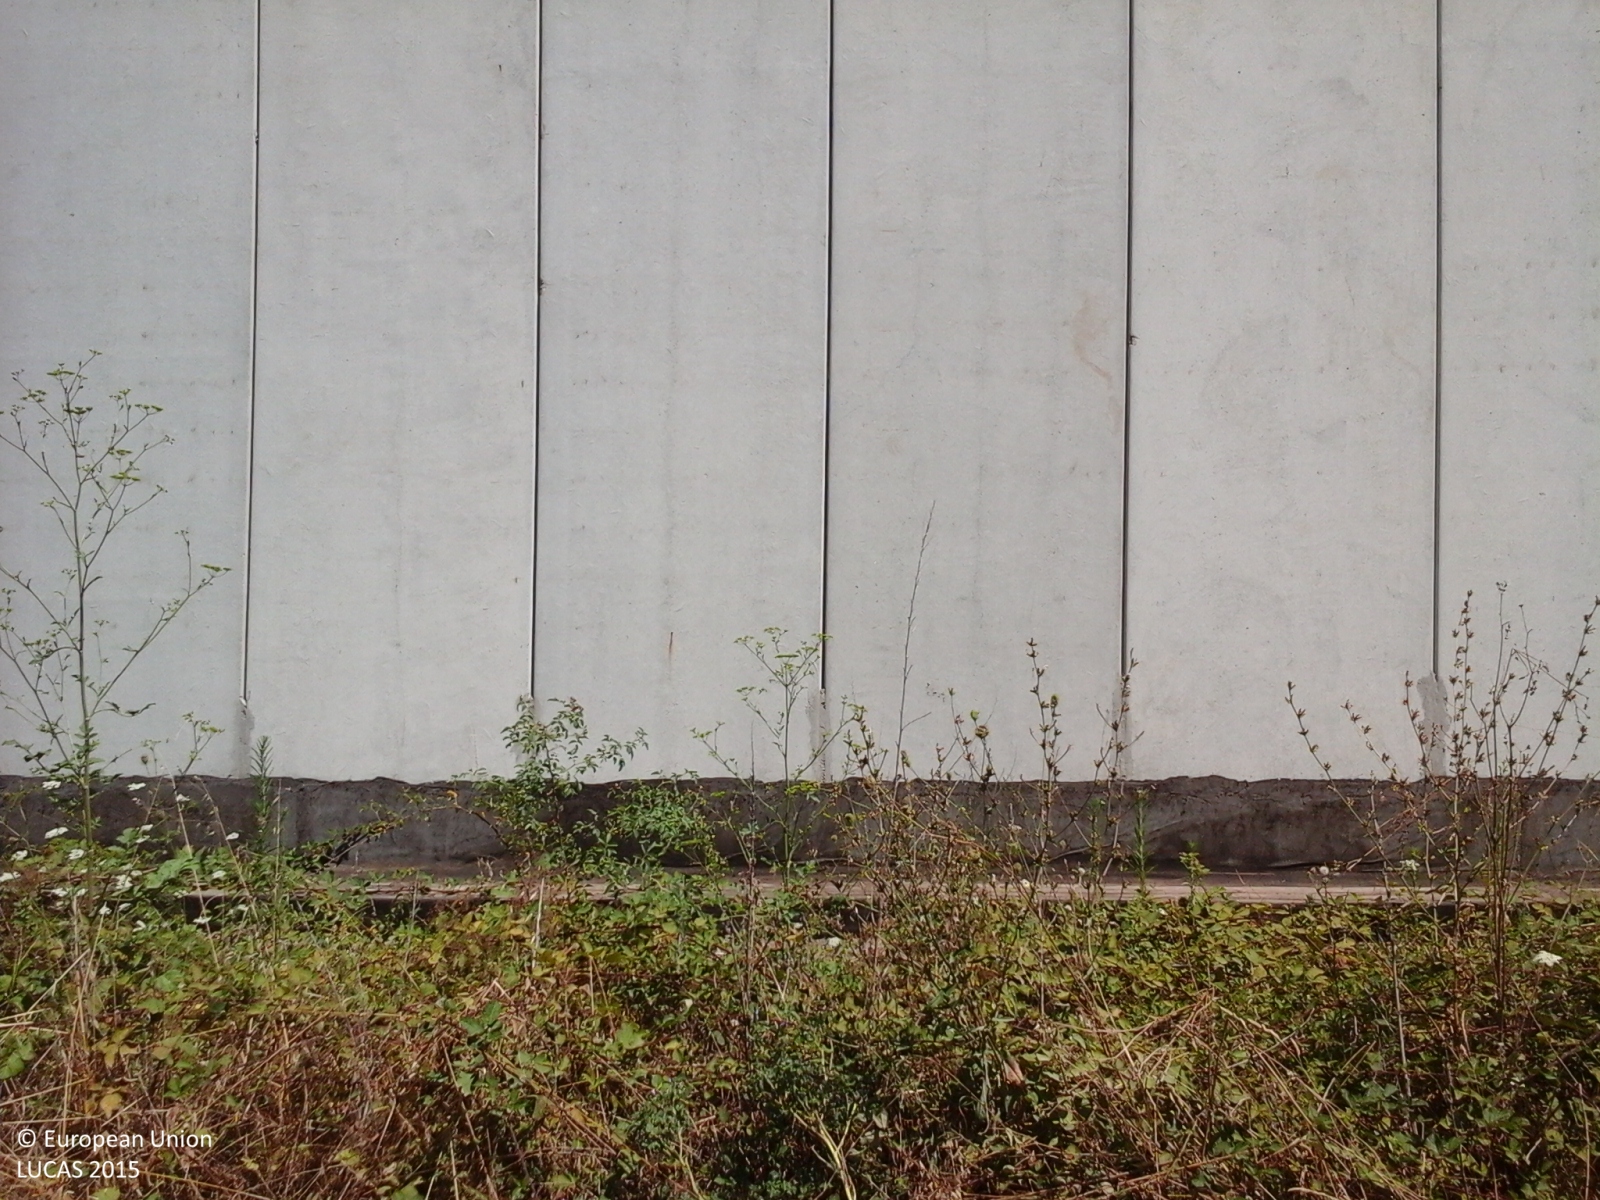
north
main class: Grassland
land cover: Grassland with sparse tree/shrub cover
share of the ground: > 75 %
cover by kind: herbaceous plants 95 %, broadleaved forest trees 5 %
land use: Community services
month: August
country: IT
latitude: 43.4597
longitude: 12.2557
